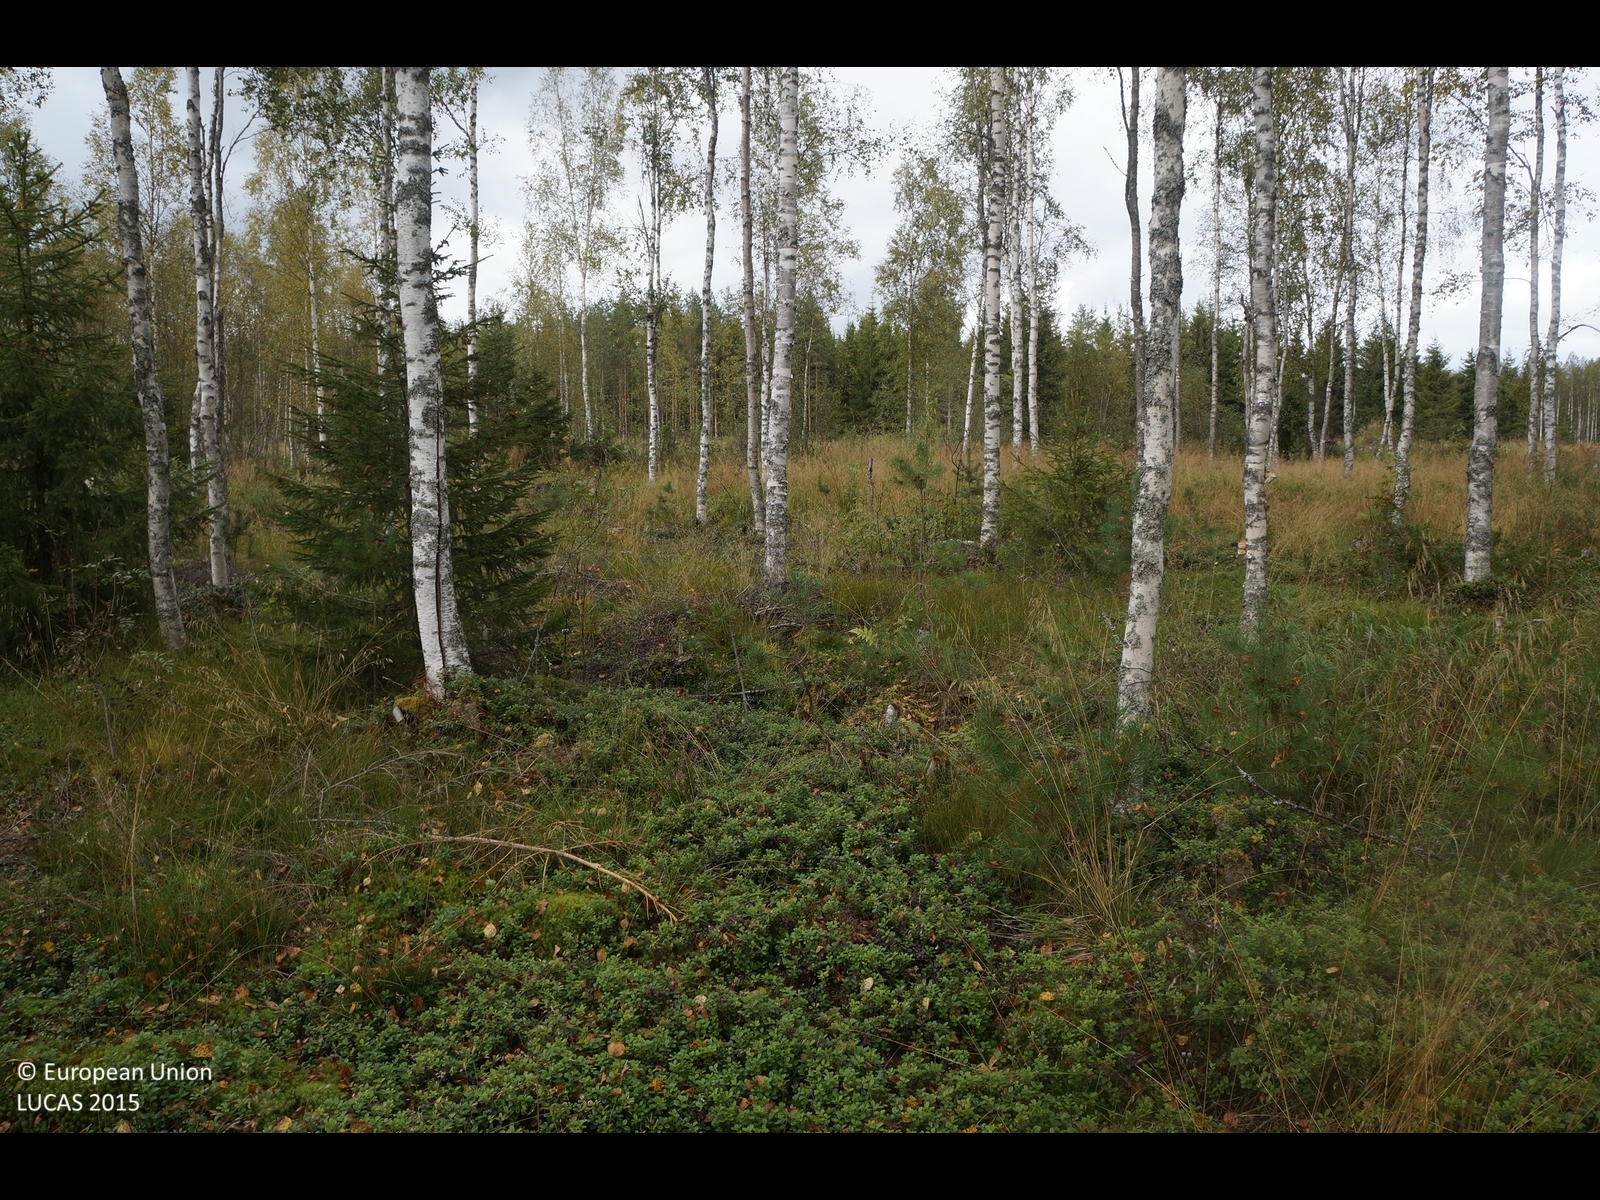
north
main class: Woodland
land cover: Broadleaved woodland
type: non-riverine alder, birch or aspen forest
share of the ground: 50 - 75 %
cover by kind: broadleaved forest trees 50 %, shrubs 20 %, herbaceous plants 20 %, lichens and mosses 10 %
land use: Forestry
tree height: > 5 m
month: September
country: FI
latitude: 64.0370
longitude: 24.3408
